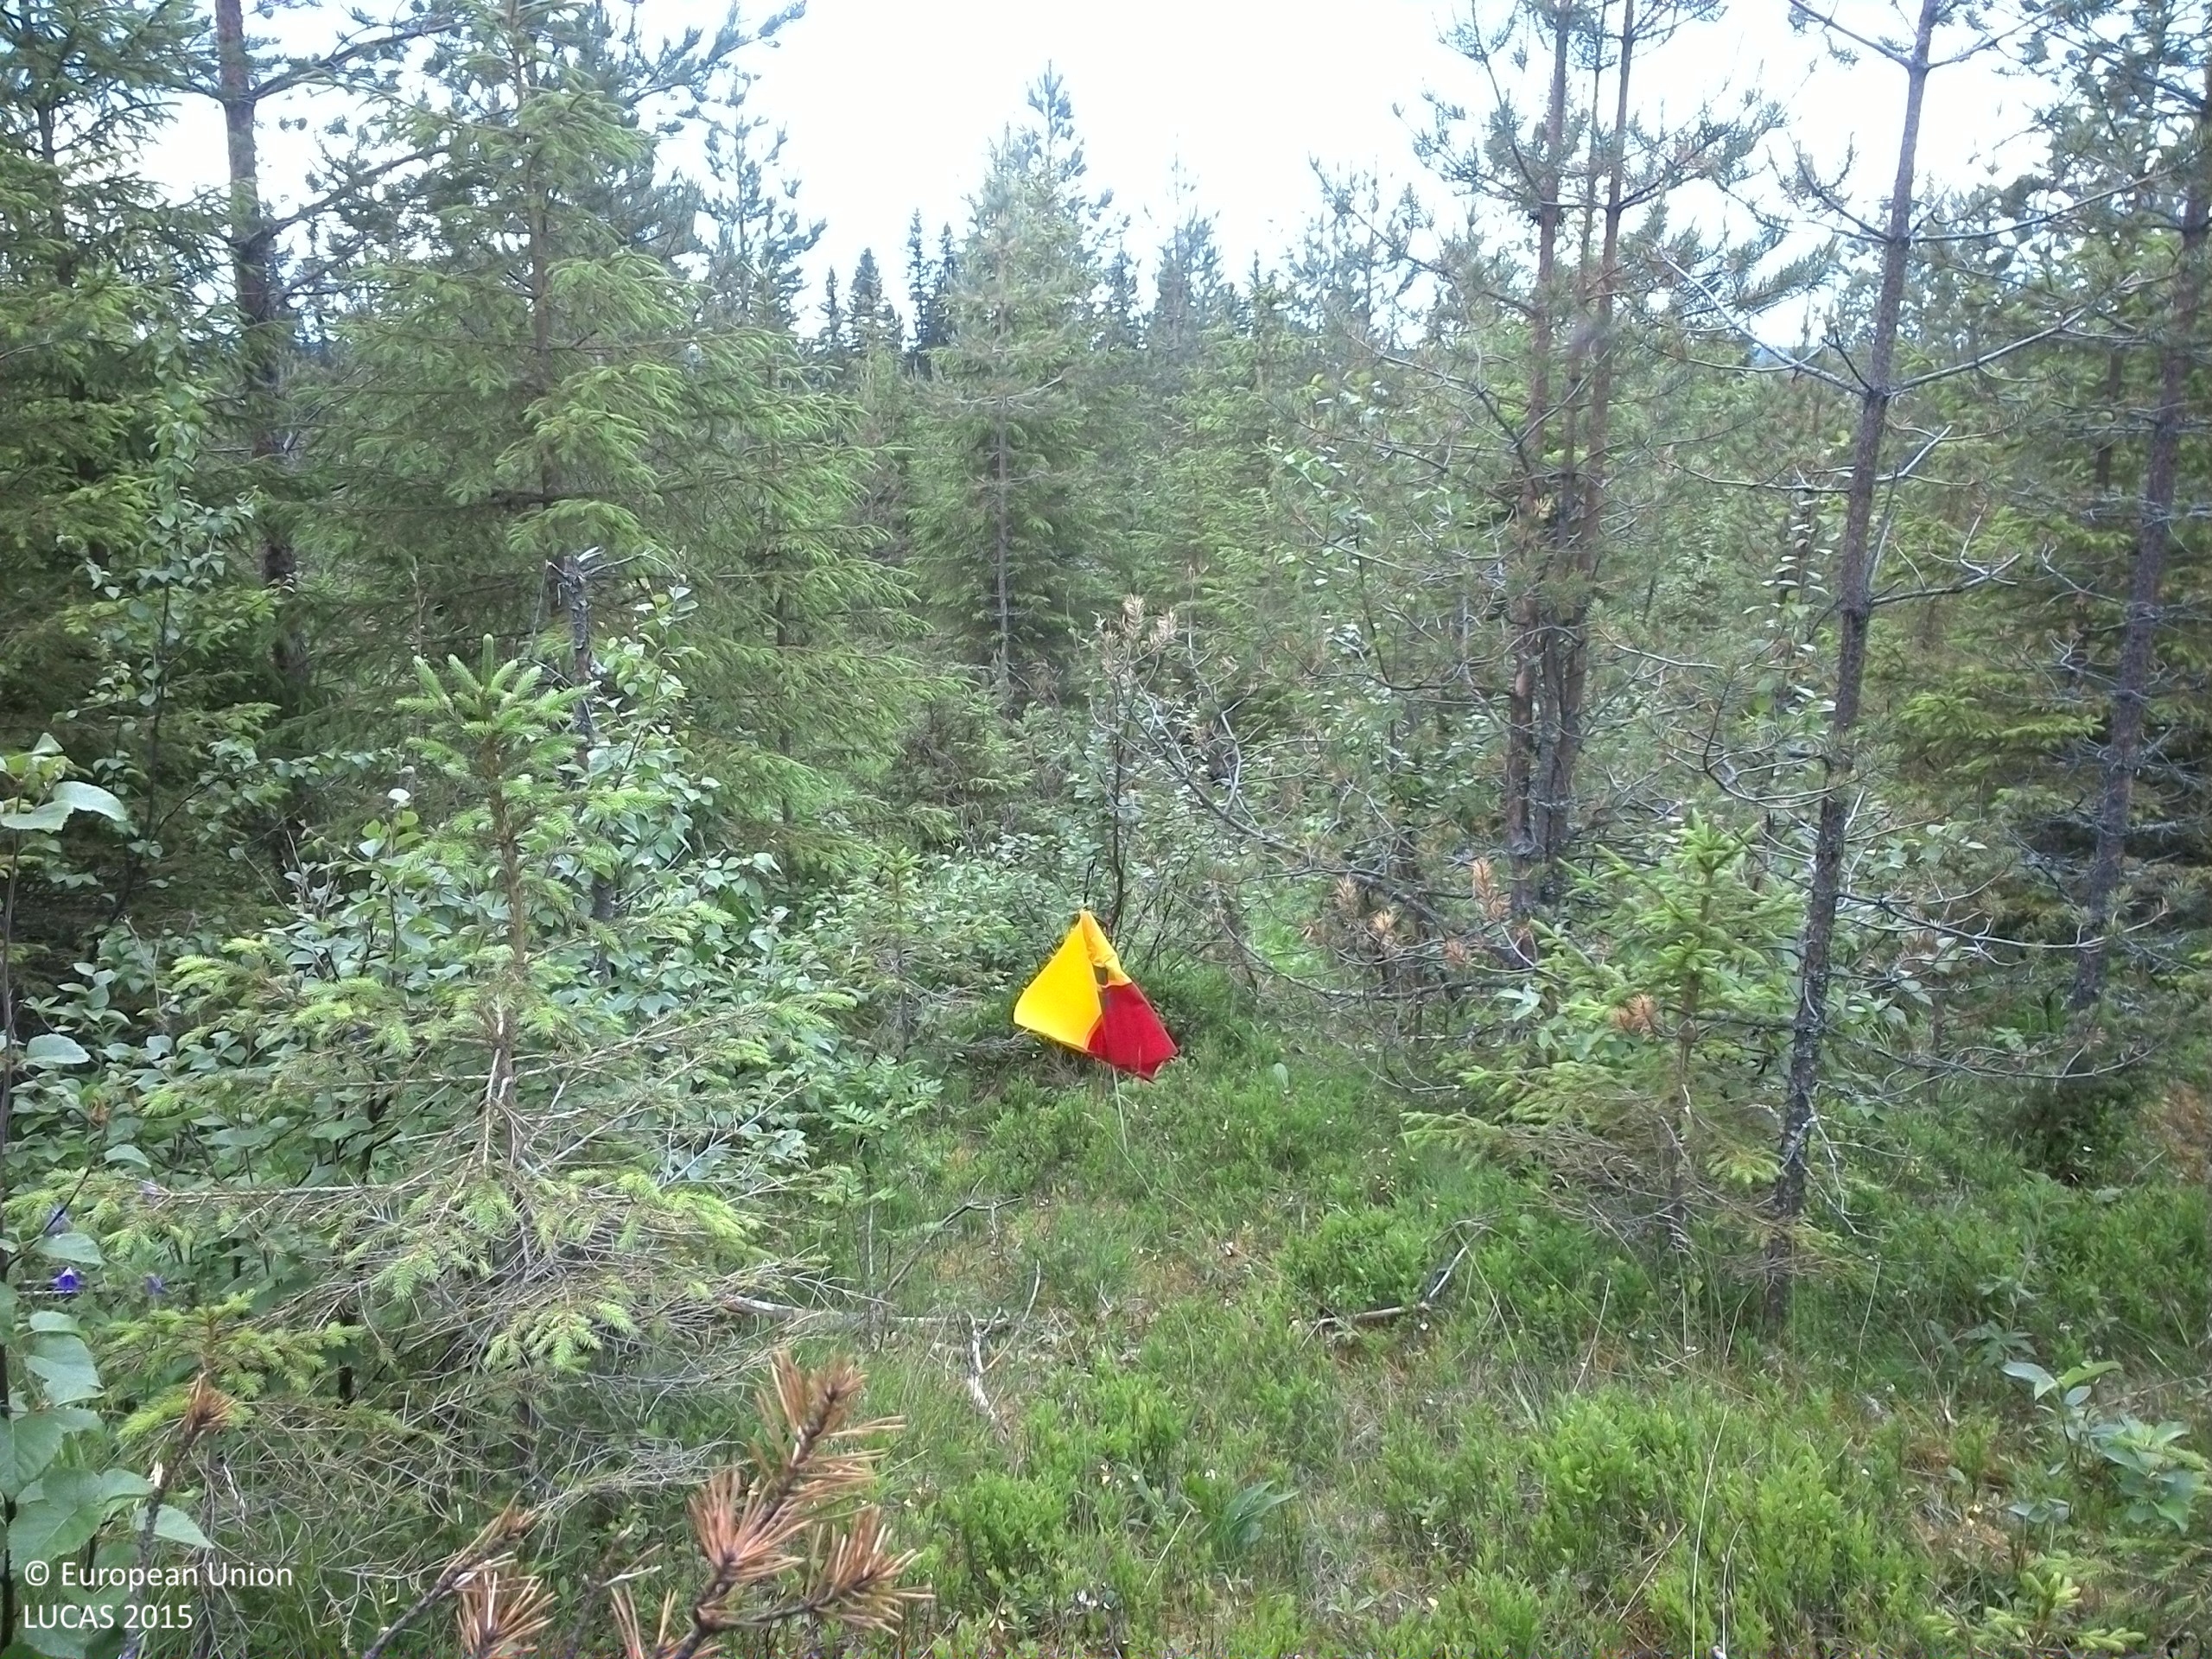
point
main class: Woodland
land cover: Pine dominated mixed woodland
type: boreal forest
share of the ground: 25 - 50 %
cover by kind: coniferous forest trees 30 %, shrubs 30 %, broadleaved forest trees 15 %, herbaceous plants 10 %, lichens and mosses 10 %, consolidated bare surface 5 %
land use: Forestry
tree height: < 5 m
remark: Clear cut
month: July
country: SE
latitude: 64.4292
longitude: 16.0117
